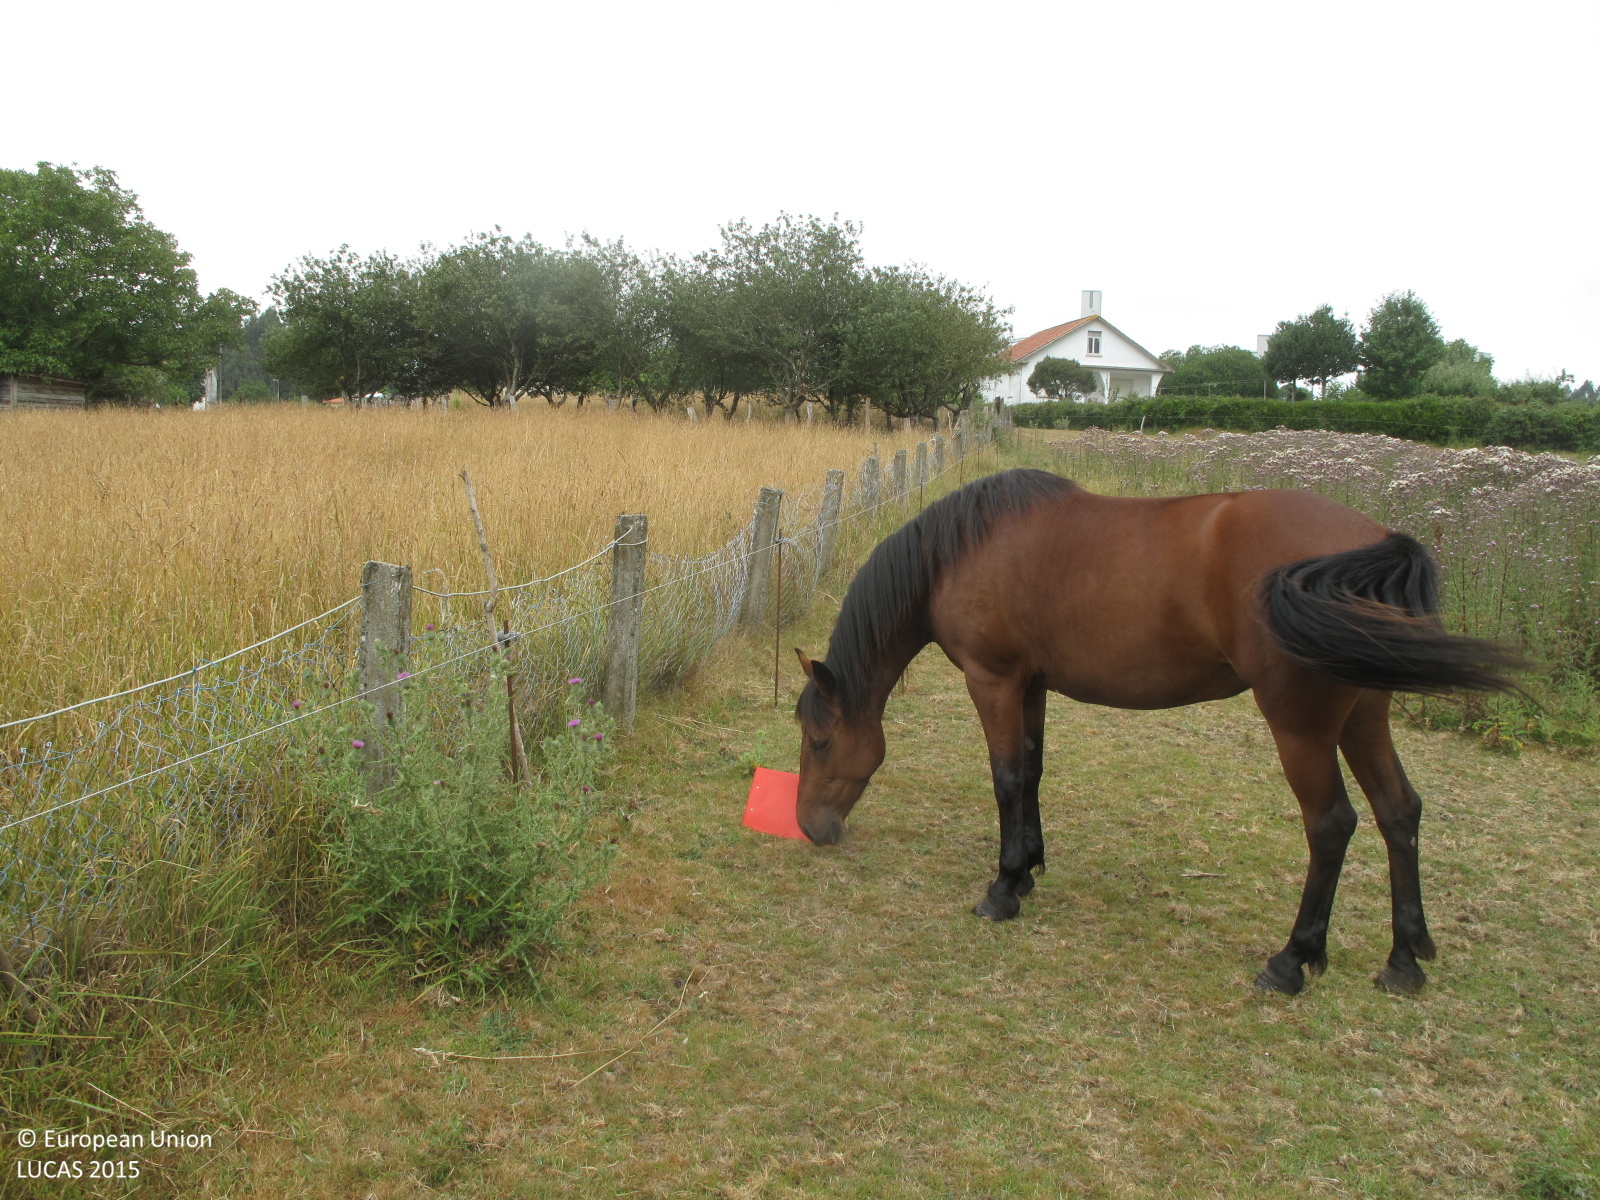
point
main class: Grassland
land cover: Grassland without tree/shrub cover
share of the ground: > 75 %
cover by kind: herbaceous plants 100 %
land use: Agriculture (excluding fallow land and kitchen gardens)
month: July
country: ES
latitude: 43.5394
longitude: -8.1828
